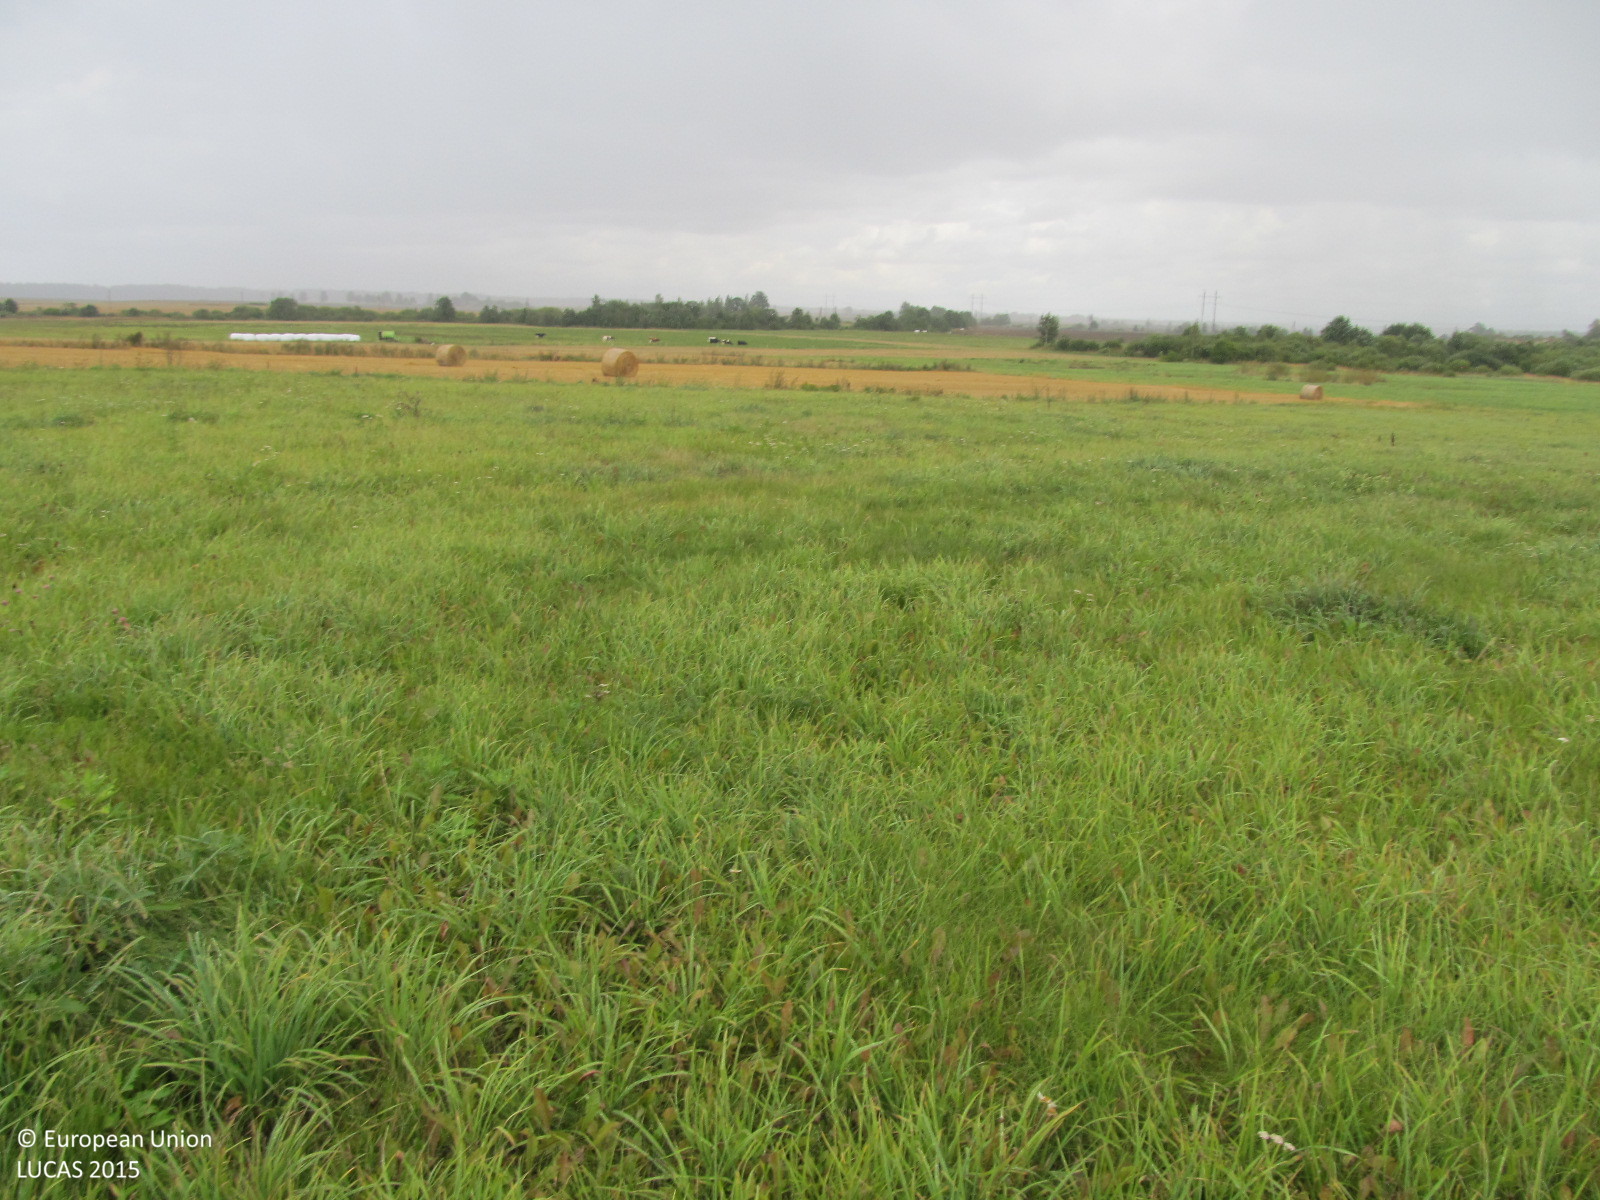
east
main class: Grassland
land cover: Grassland without tree/shrub cover
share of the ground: > 75 %
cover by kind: herbaceous plants 100 %
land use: Agriculture (excluding fallow land and kitchen gardens)
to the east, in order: Grassland without tree/shrub cover; Common wheat; Shruby margins; Barley; Dry pulses; Fences; Grassland without tree/shrub cover
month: September
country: LT
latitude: 56.2542
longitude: 23.1600
